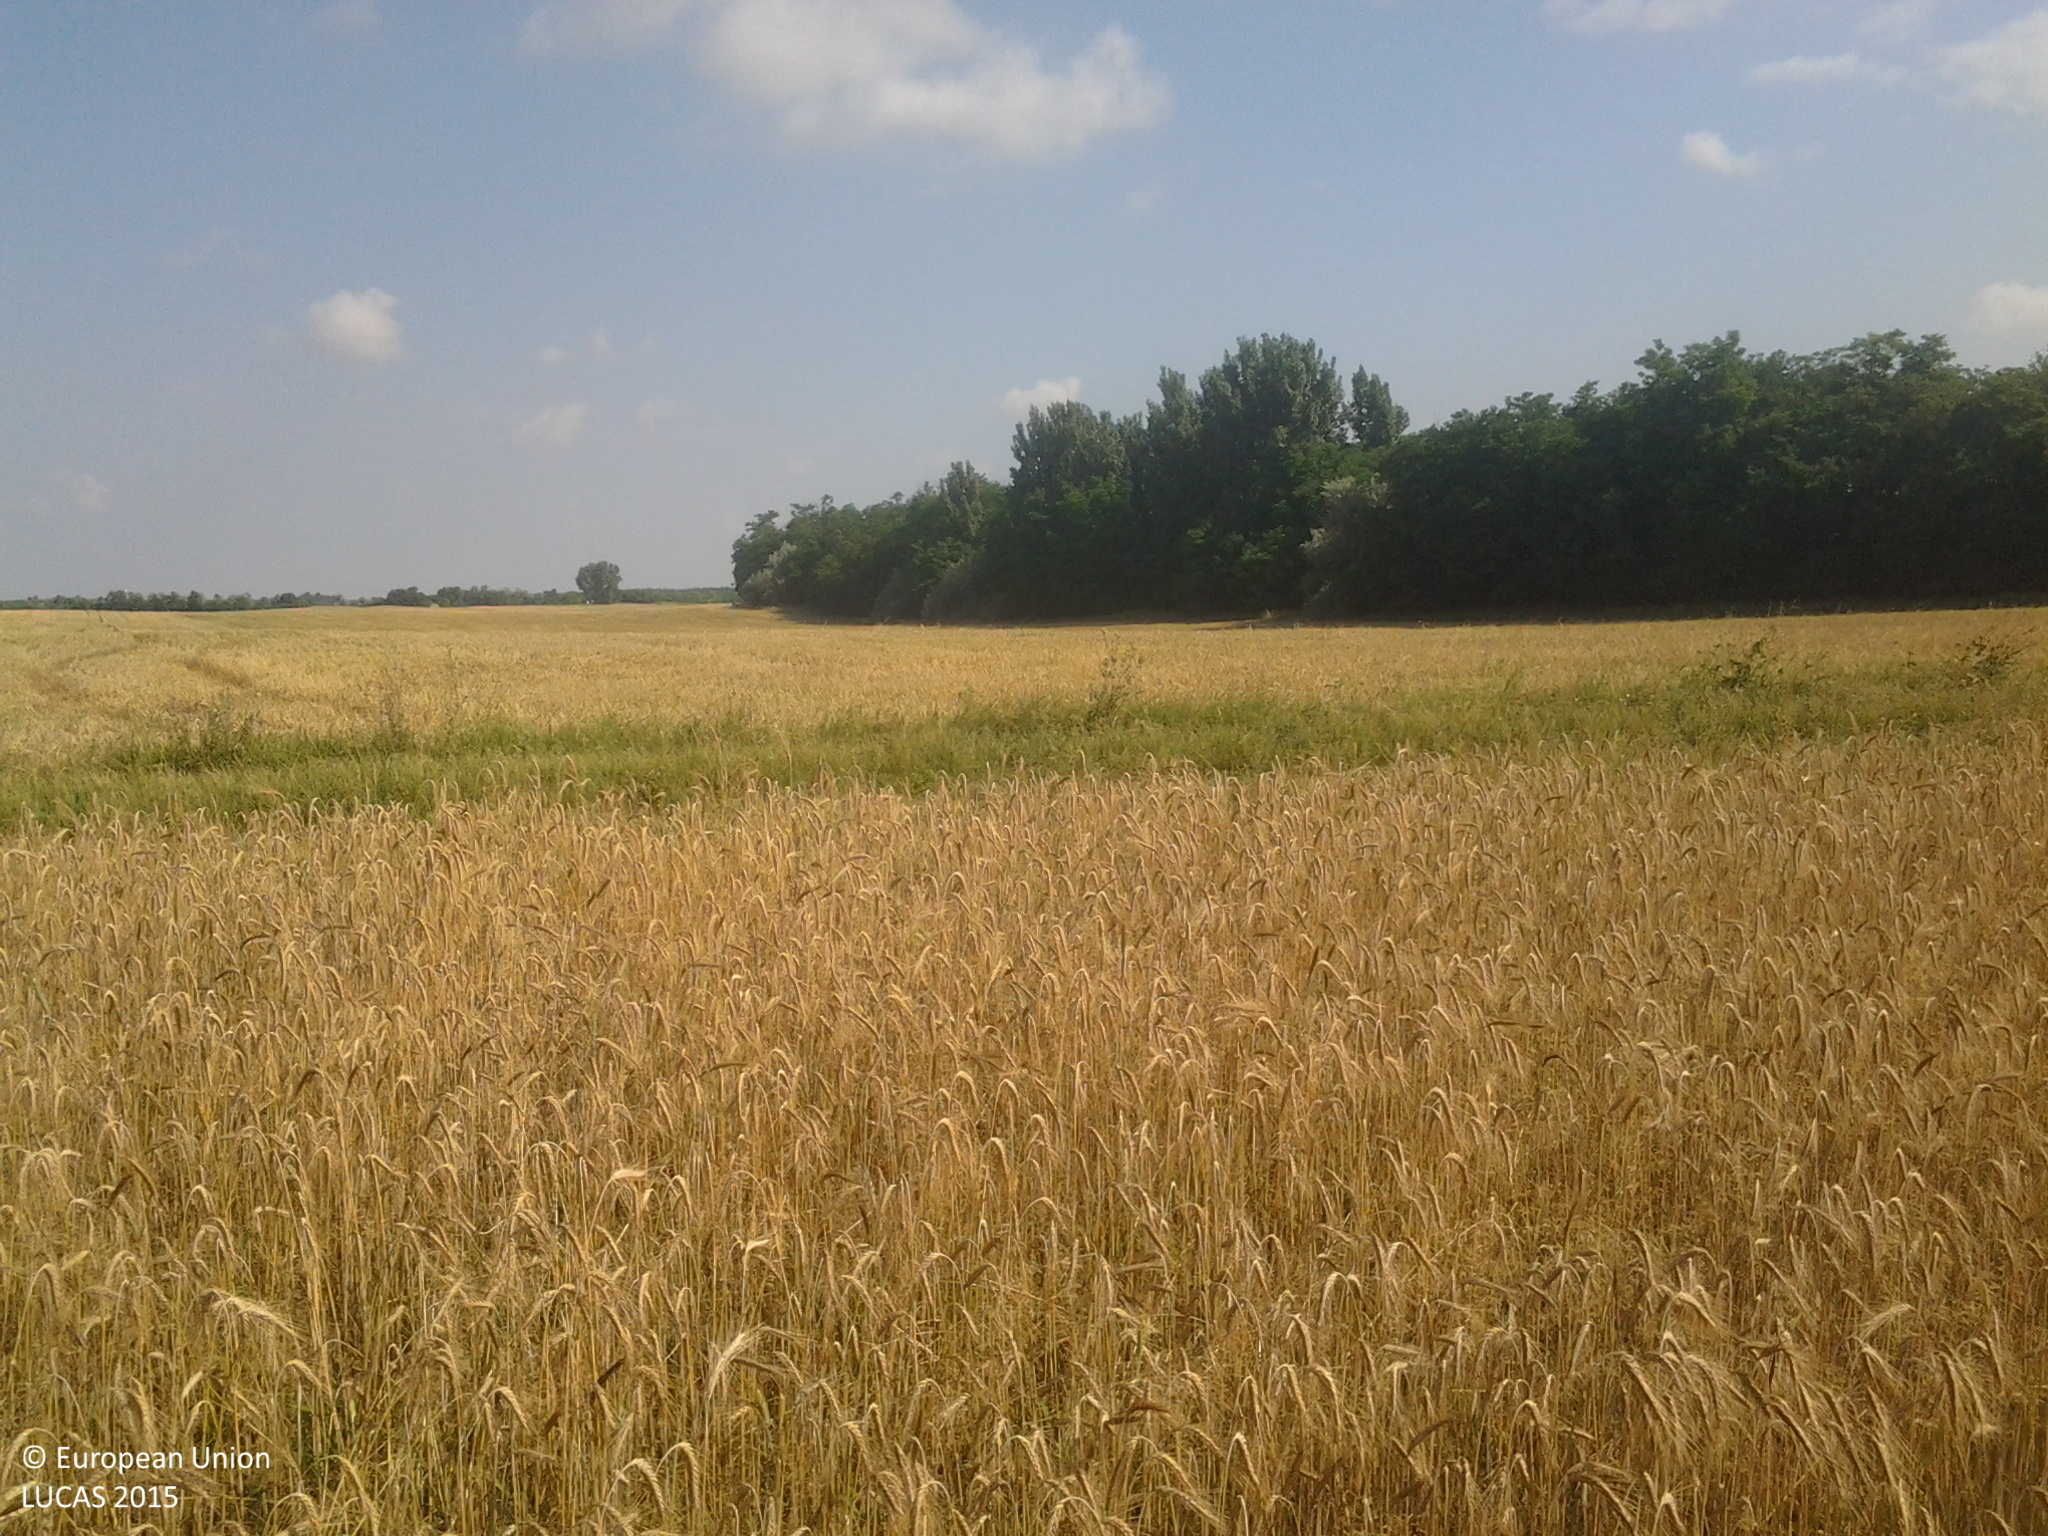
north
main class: Cropland
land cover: Barley
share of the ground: > 75 %
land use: Agriculture (excluding fallow land and kitchen gardens)
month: June
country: HU
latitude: 46.7216
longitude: 19.7414
